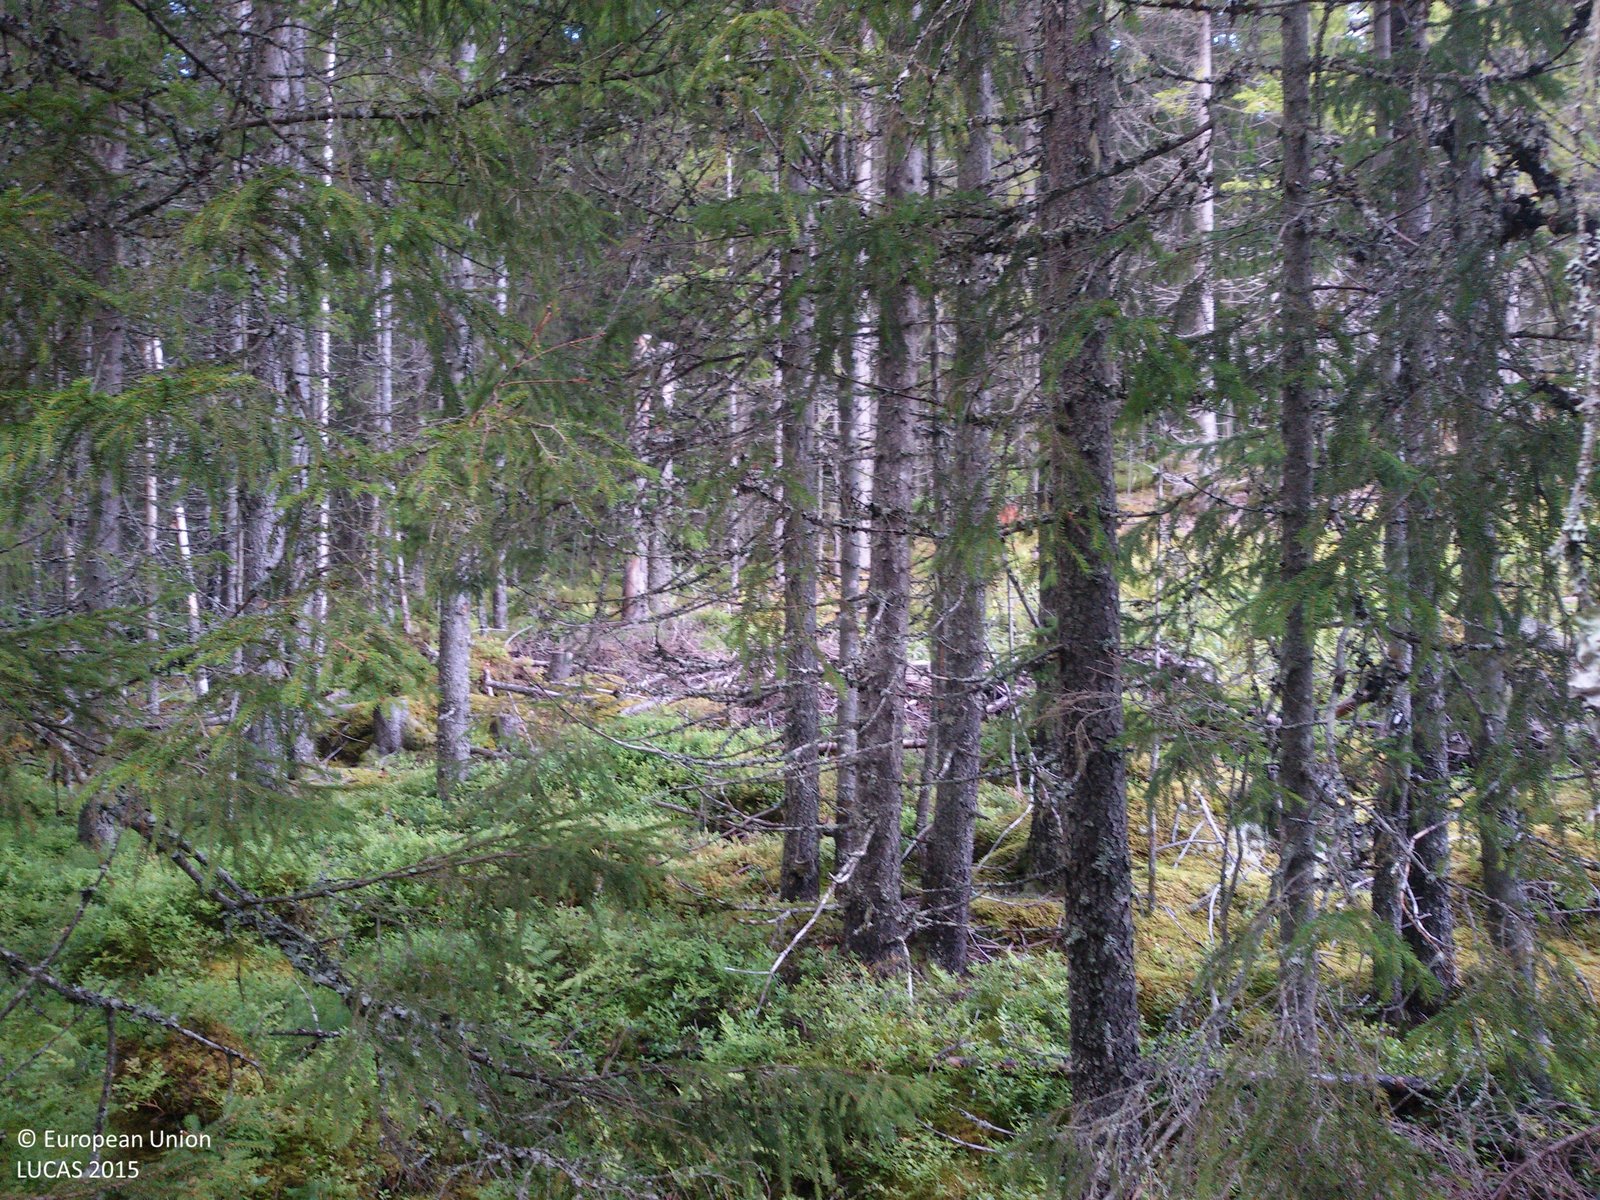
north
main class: Woodland
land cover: Spruce dominated coniferous woodland
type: boreal forest
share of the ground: > 75 %
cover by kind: coniferous forest trees 80 %, herbaceous plants 10 %, lichens and mosses 10 %
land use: Forestry
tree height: > 5 m
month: September
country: SE
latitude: 61.0848
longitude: 15.4920
